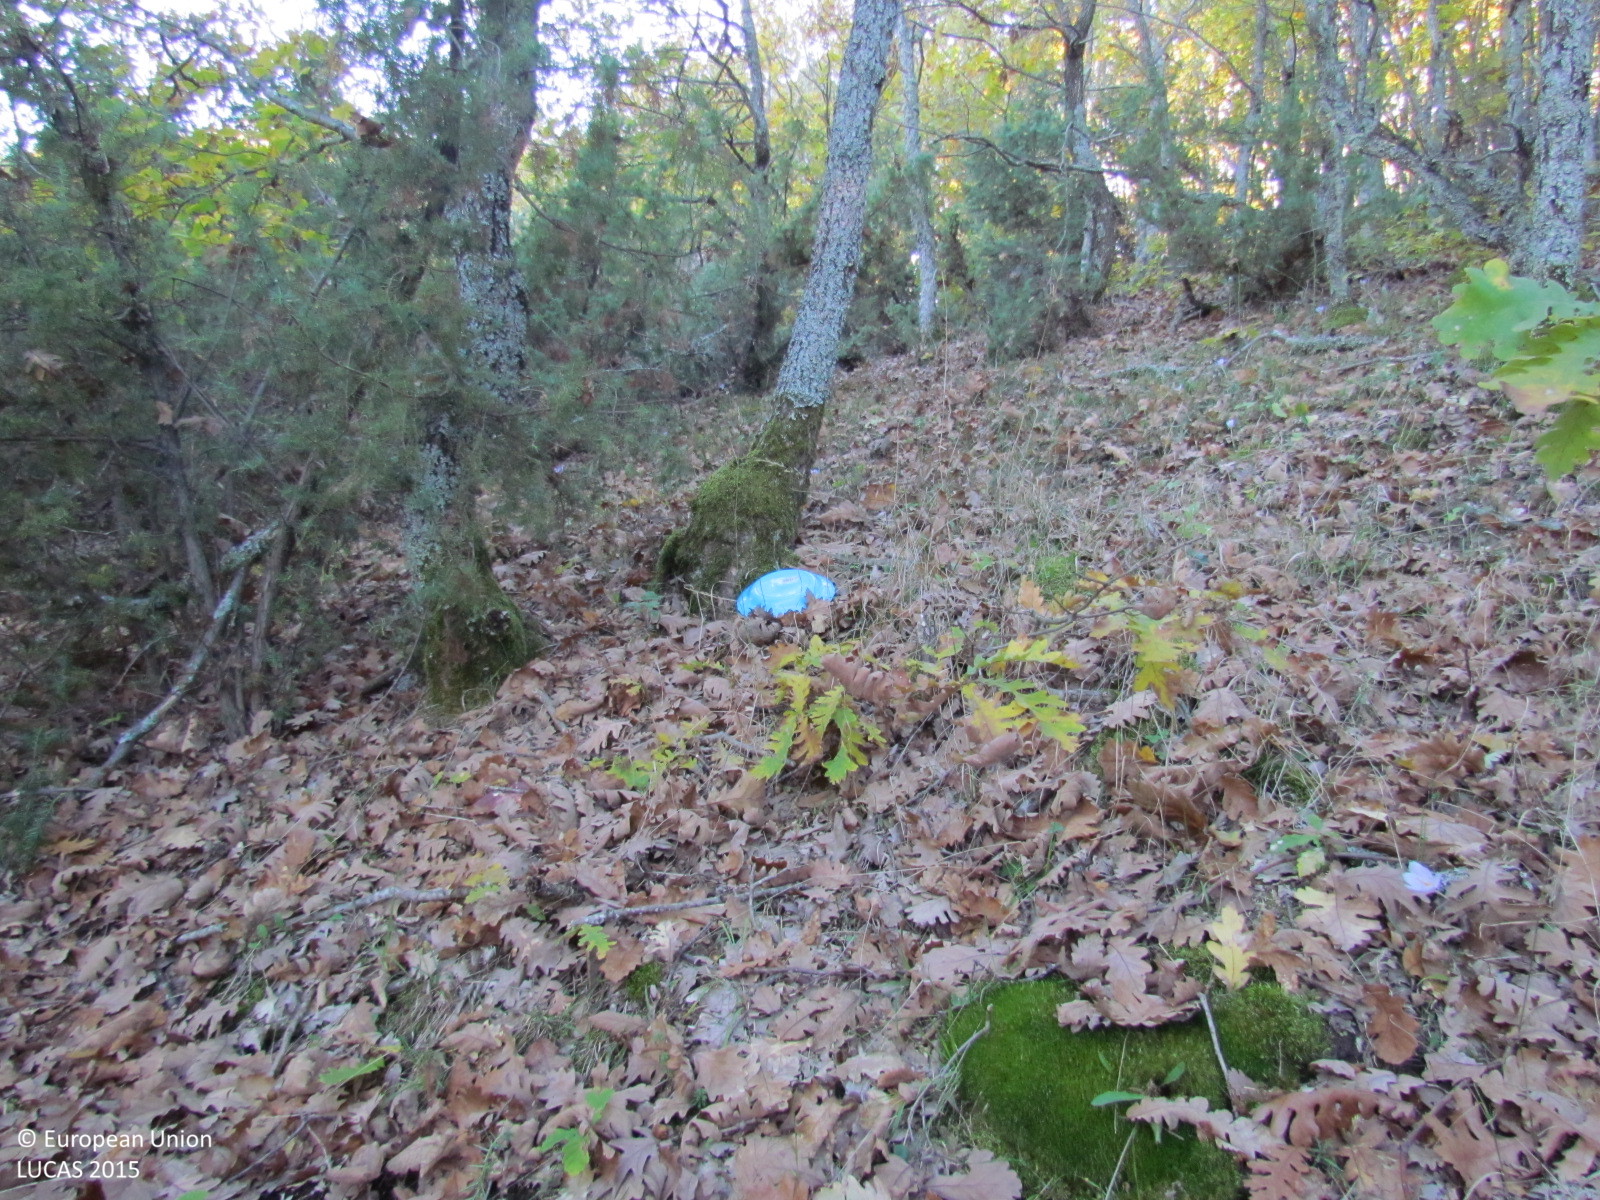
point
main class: Woodland
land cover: Broadleaved woodland
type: acidophilous oak and oak-birch forest
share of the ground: 50 - 75 %
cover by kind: broadleaved forest trees 70 %, unconsolidated bare surface 20 %, herbaceous plants 5 %, lichens and mosses 5 %
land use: Forestry
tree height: > 5 m
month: November
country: BG
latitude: 41.3969
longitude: 25.6192
